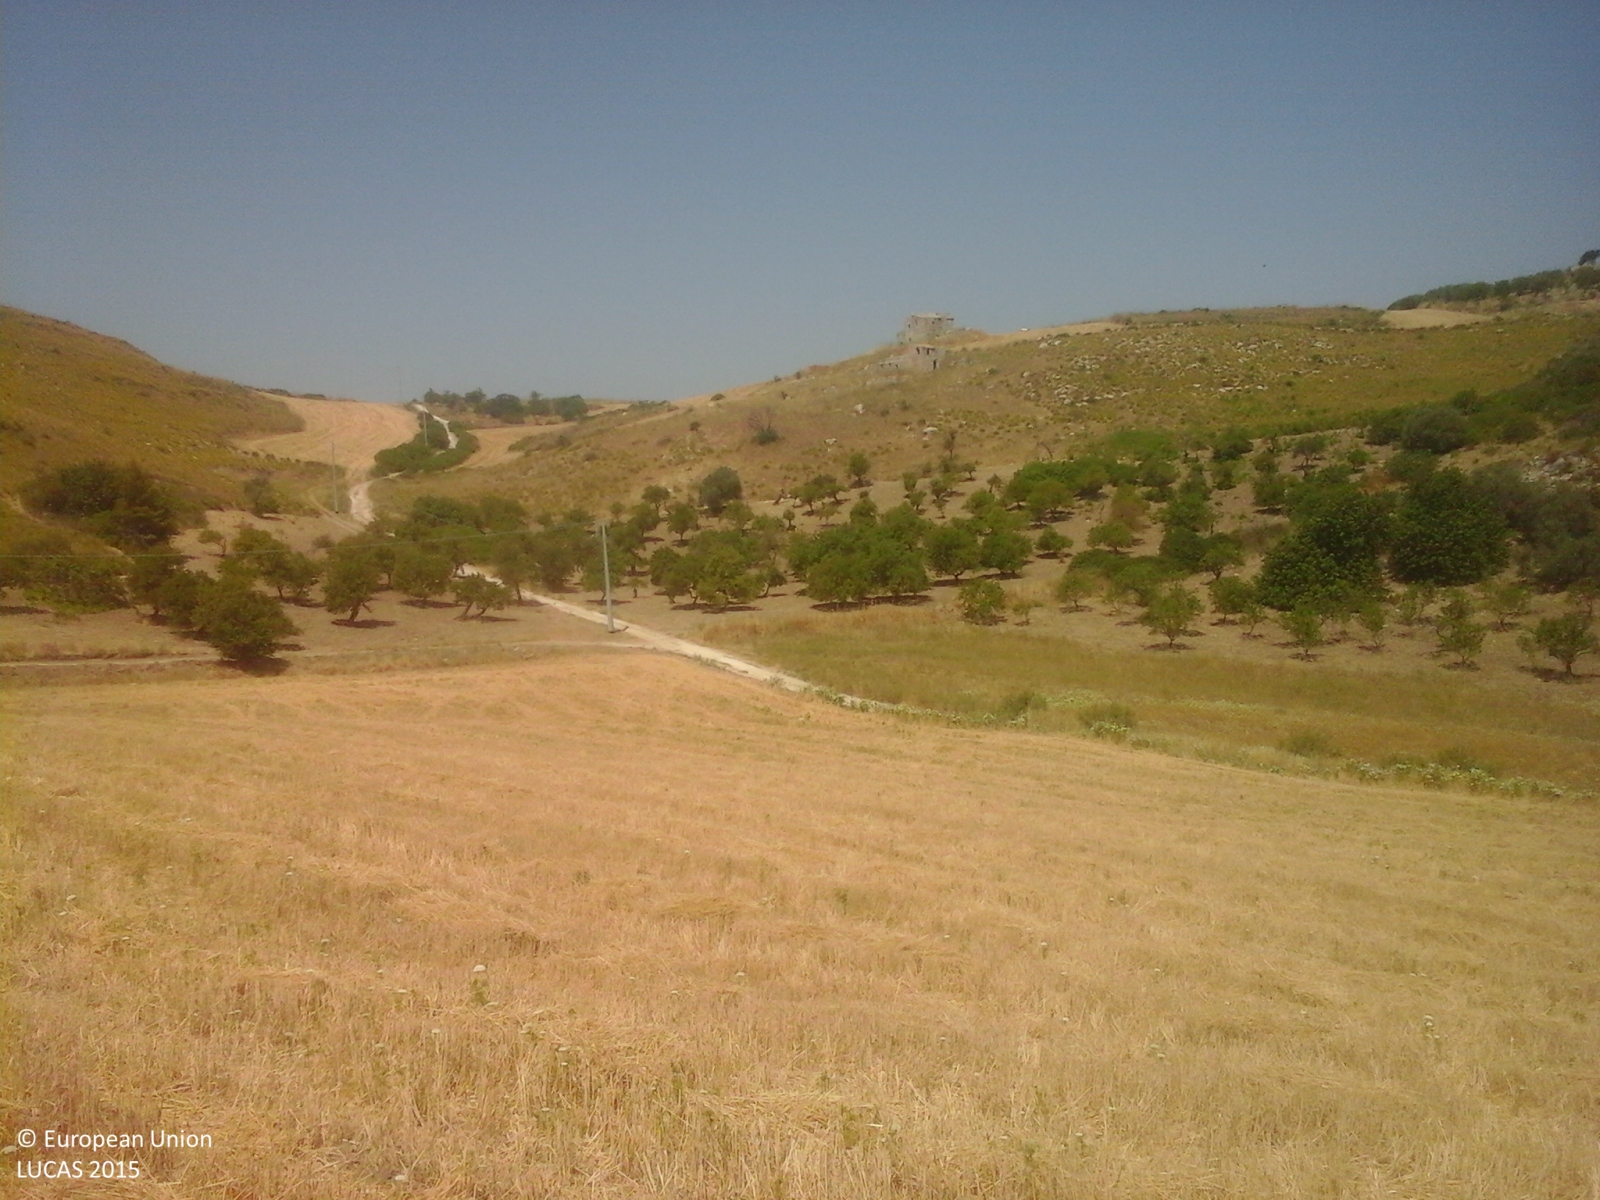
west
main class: Cropland
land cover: Durum wheat
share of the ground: > 75 %
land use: Agriculture (excluding fallow land and kitchen gardens)
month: July
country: IT
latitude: 37.4646
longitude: 13.5120
